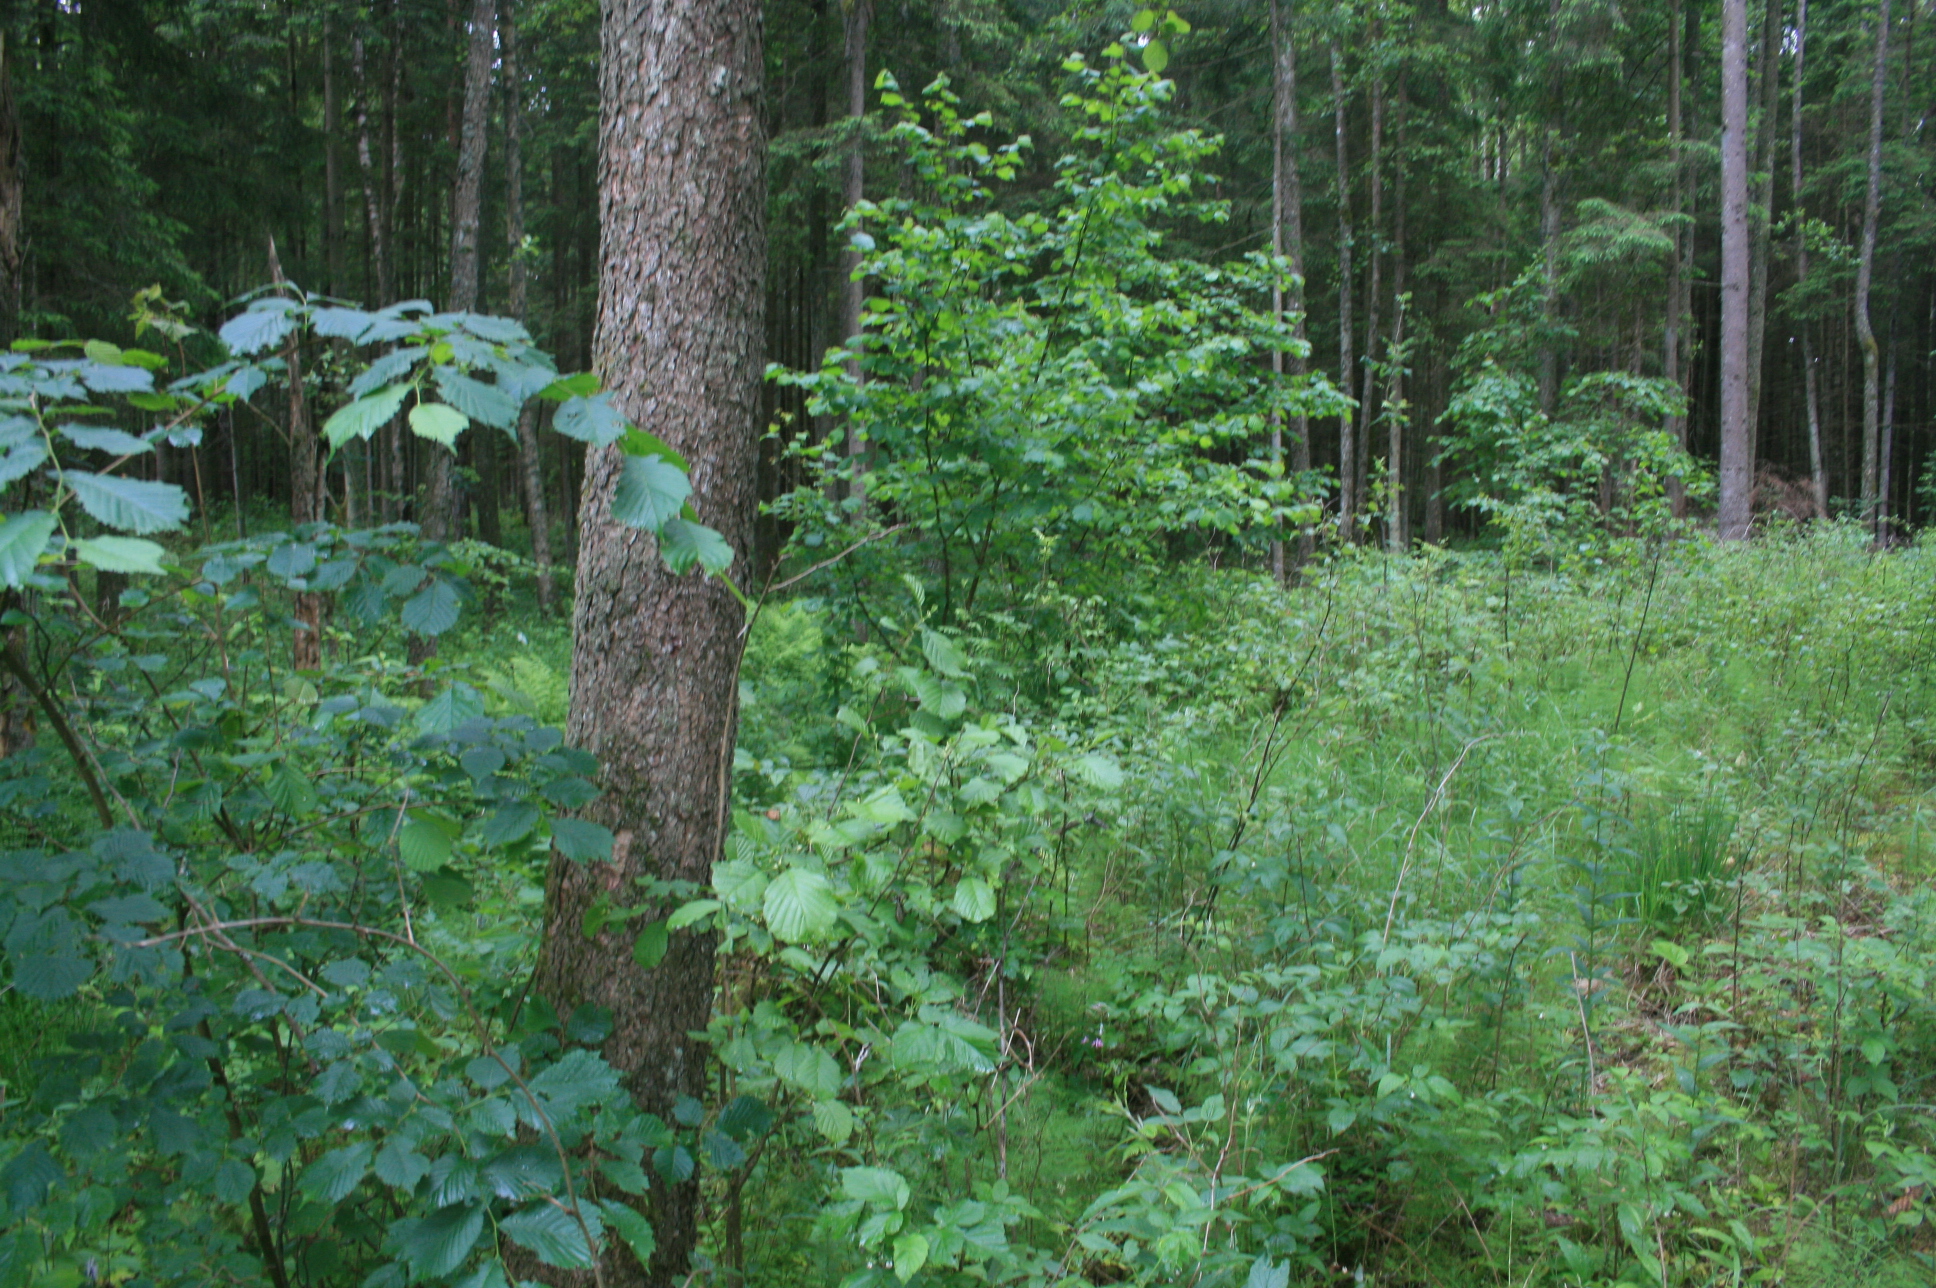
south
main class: Woodland
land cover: Spruce dominated mixed woodland
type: hemiboreal forest and nemoral coniferous forest and mixed broadleaved-coniferous forest
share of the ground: 50 - 75 %
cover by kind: coniferous forest trees 50 %, herbaceous plants 30 %, broadleaved forest trees 20 %
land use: Forestry
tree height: > 5 m
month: June
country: LT
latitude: 55.3527
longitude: 22.1529
